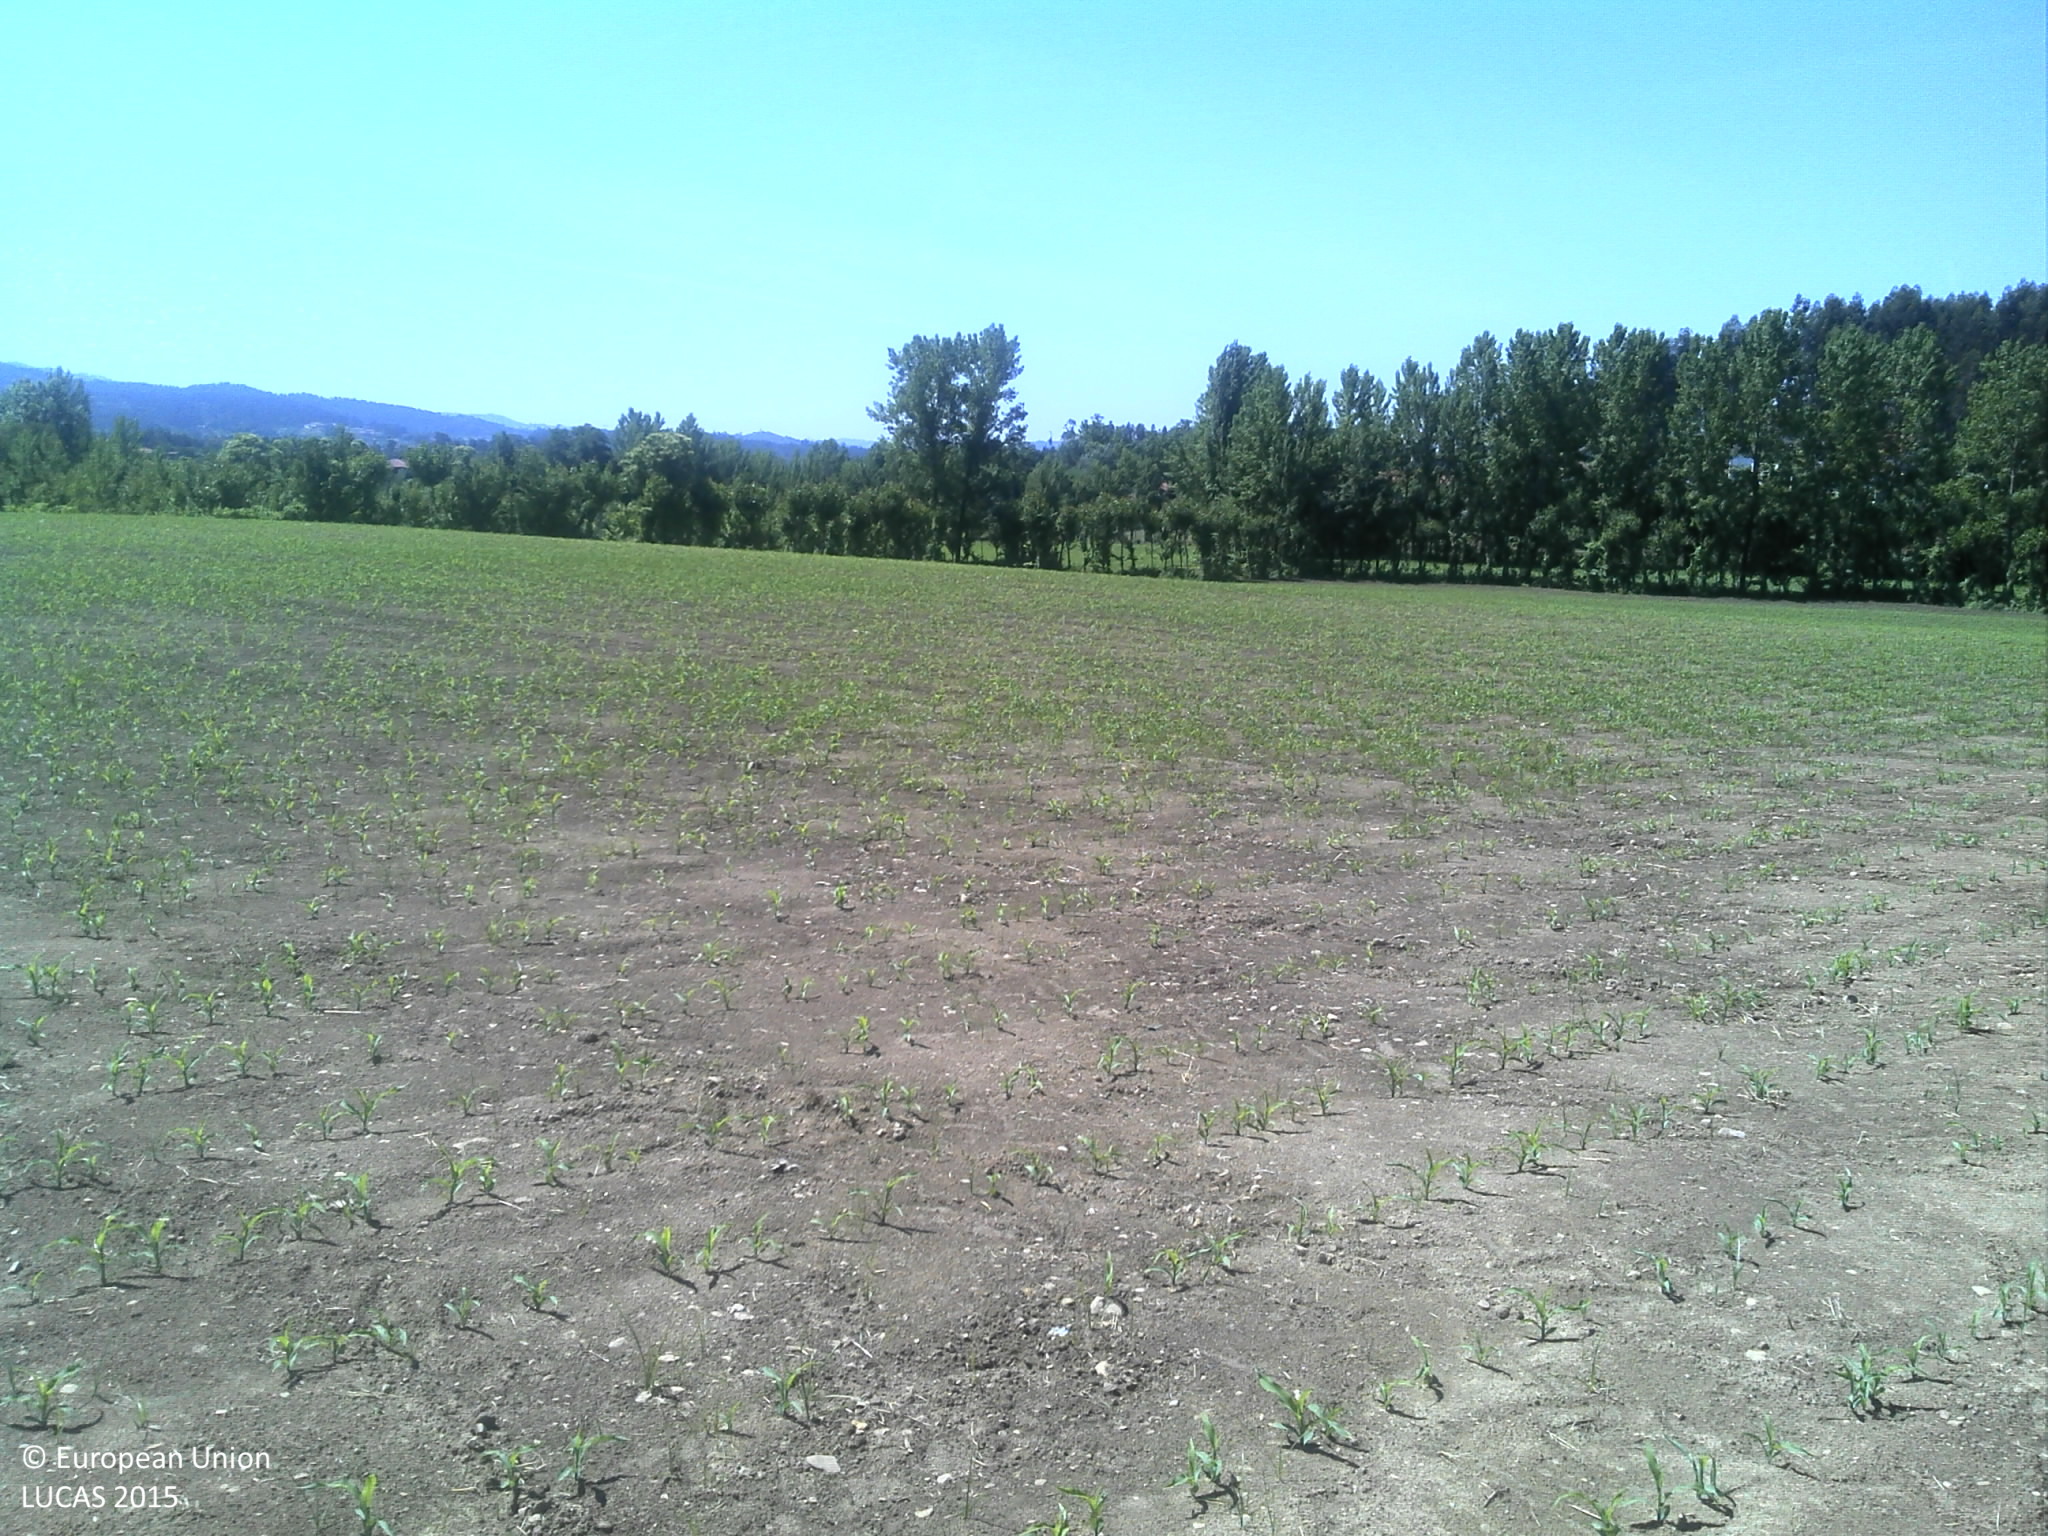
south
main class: Cropland
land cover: Maize
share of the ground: 10 - 25 %
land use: Agriculture (excluding fallow land and kitchen gardens)
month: June
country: PT
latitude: 41.5187
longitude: -8.3286
